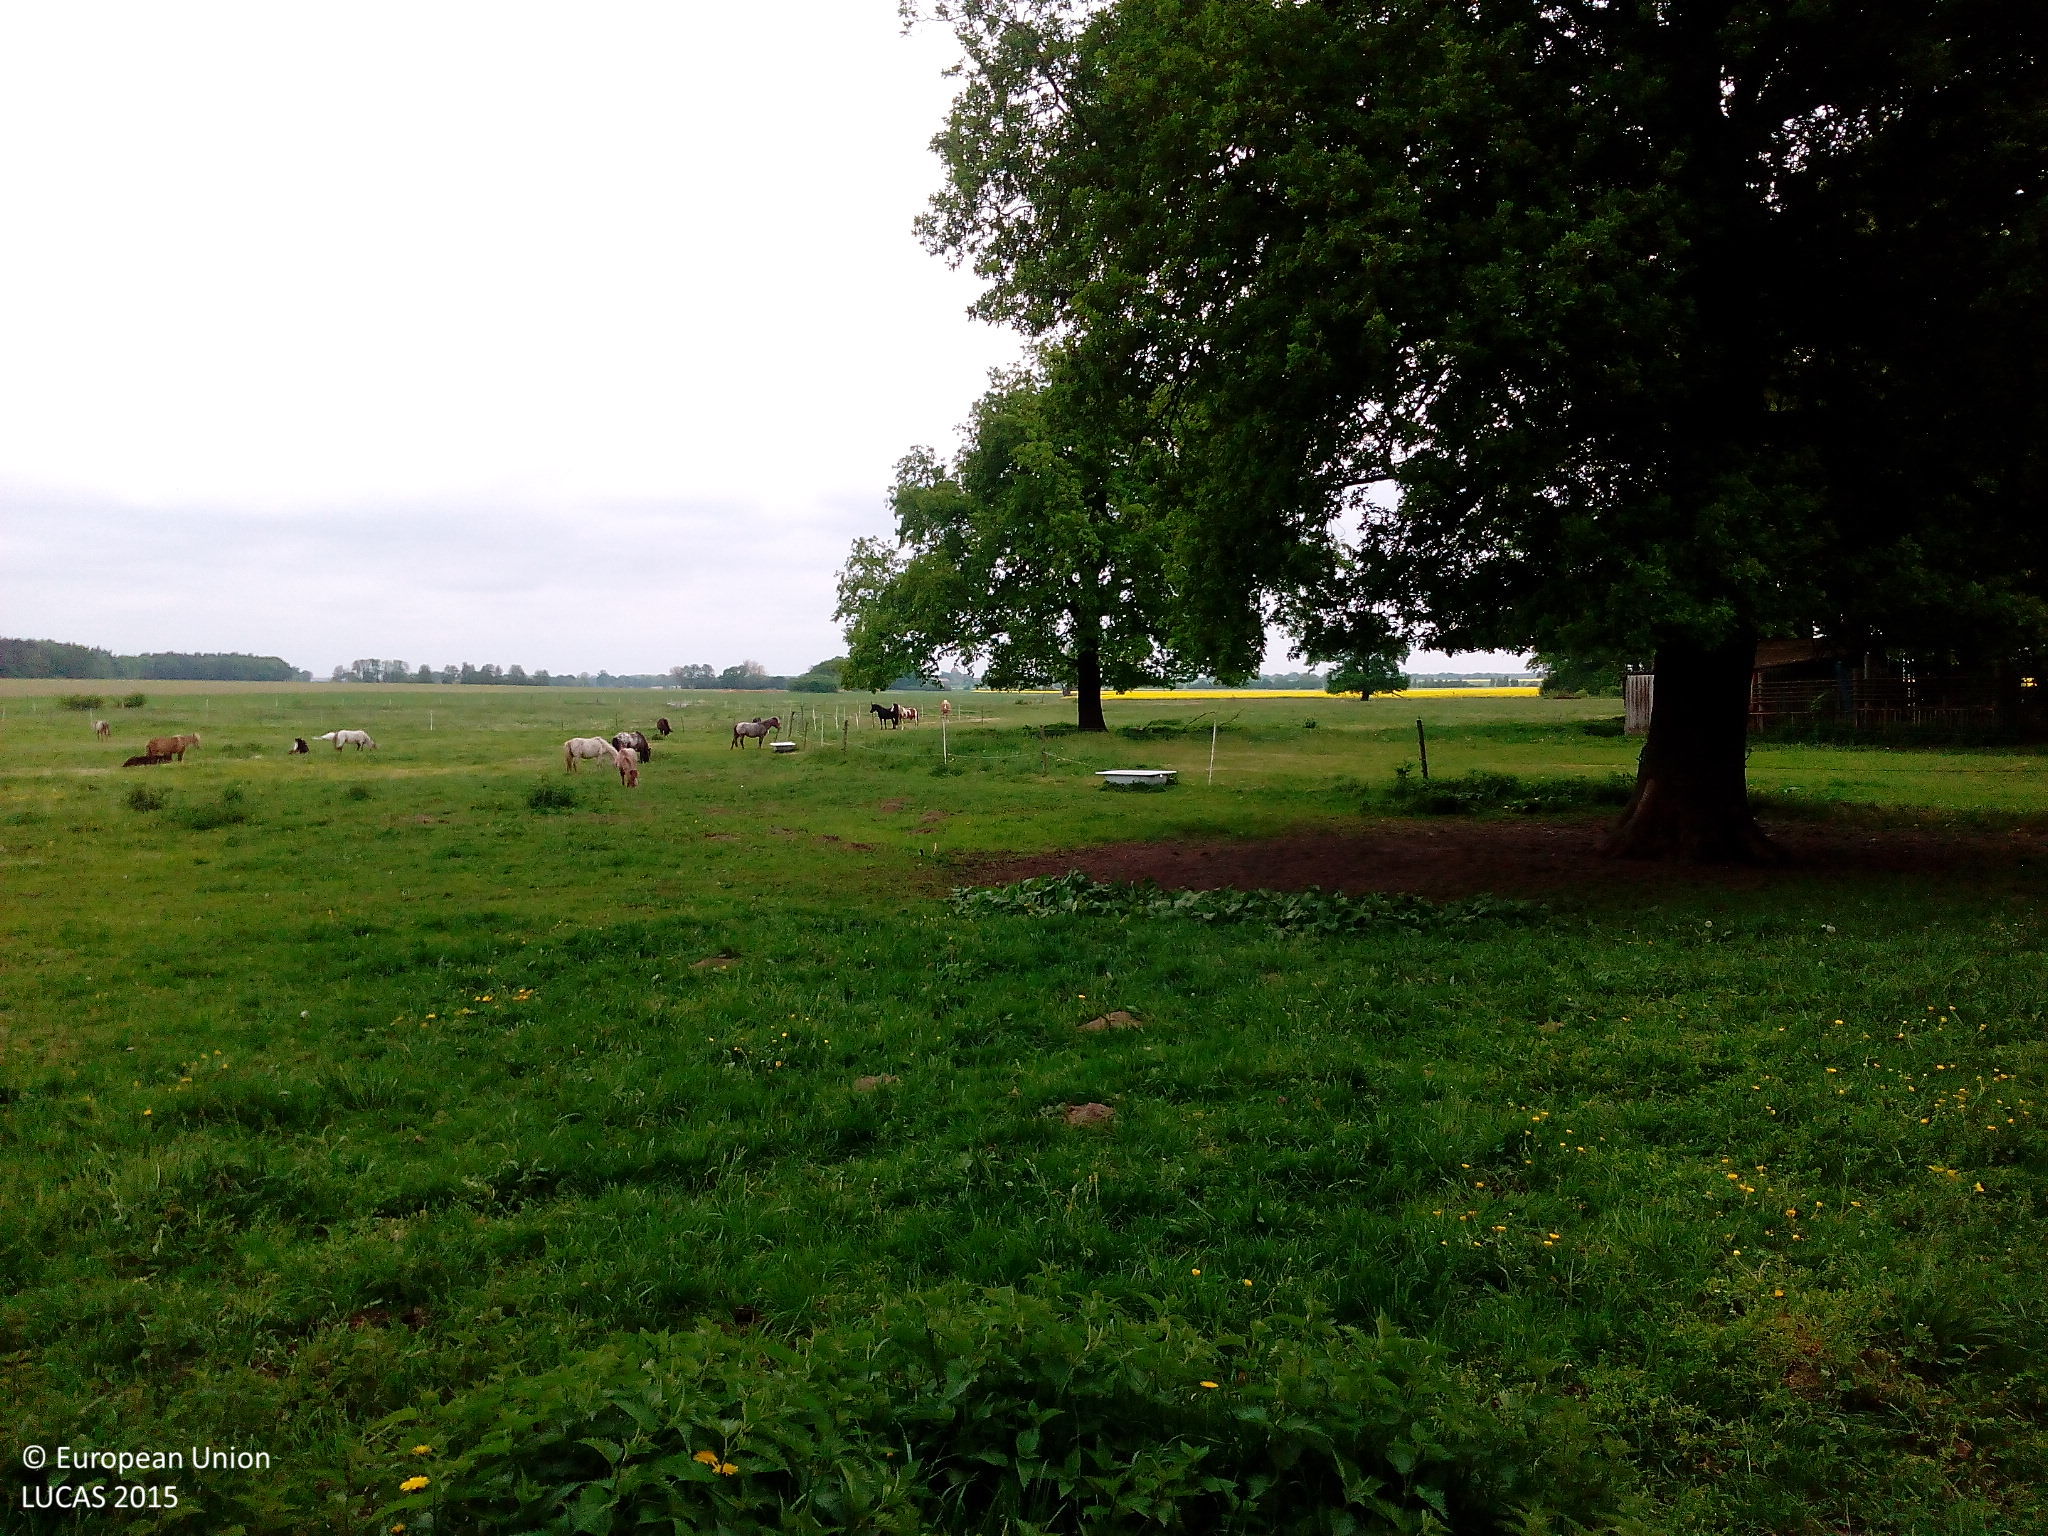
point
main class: Woodland
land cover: Broadleaved woodland
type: mesophytic deciduous forest
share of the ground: 10 - 25 %
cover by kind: herbaceous plants 80 %, broadleaved forest trees 20 %
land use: Agriculture (excluding fallow land and kitchen gardens)
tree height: > 5 m
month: May
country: DE
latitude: 52.8159
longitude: 11.6168
